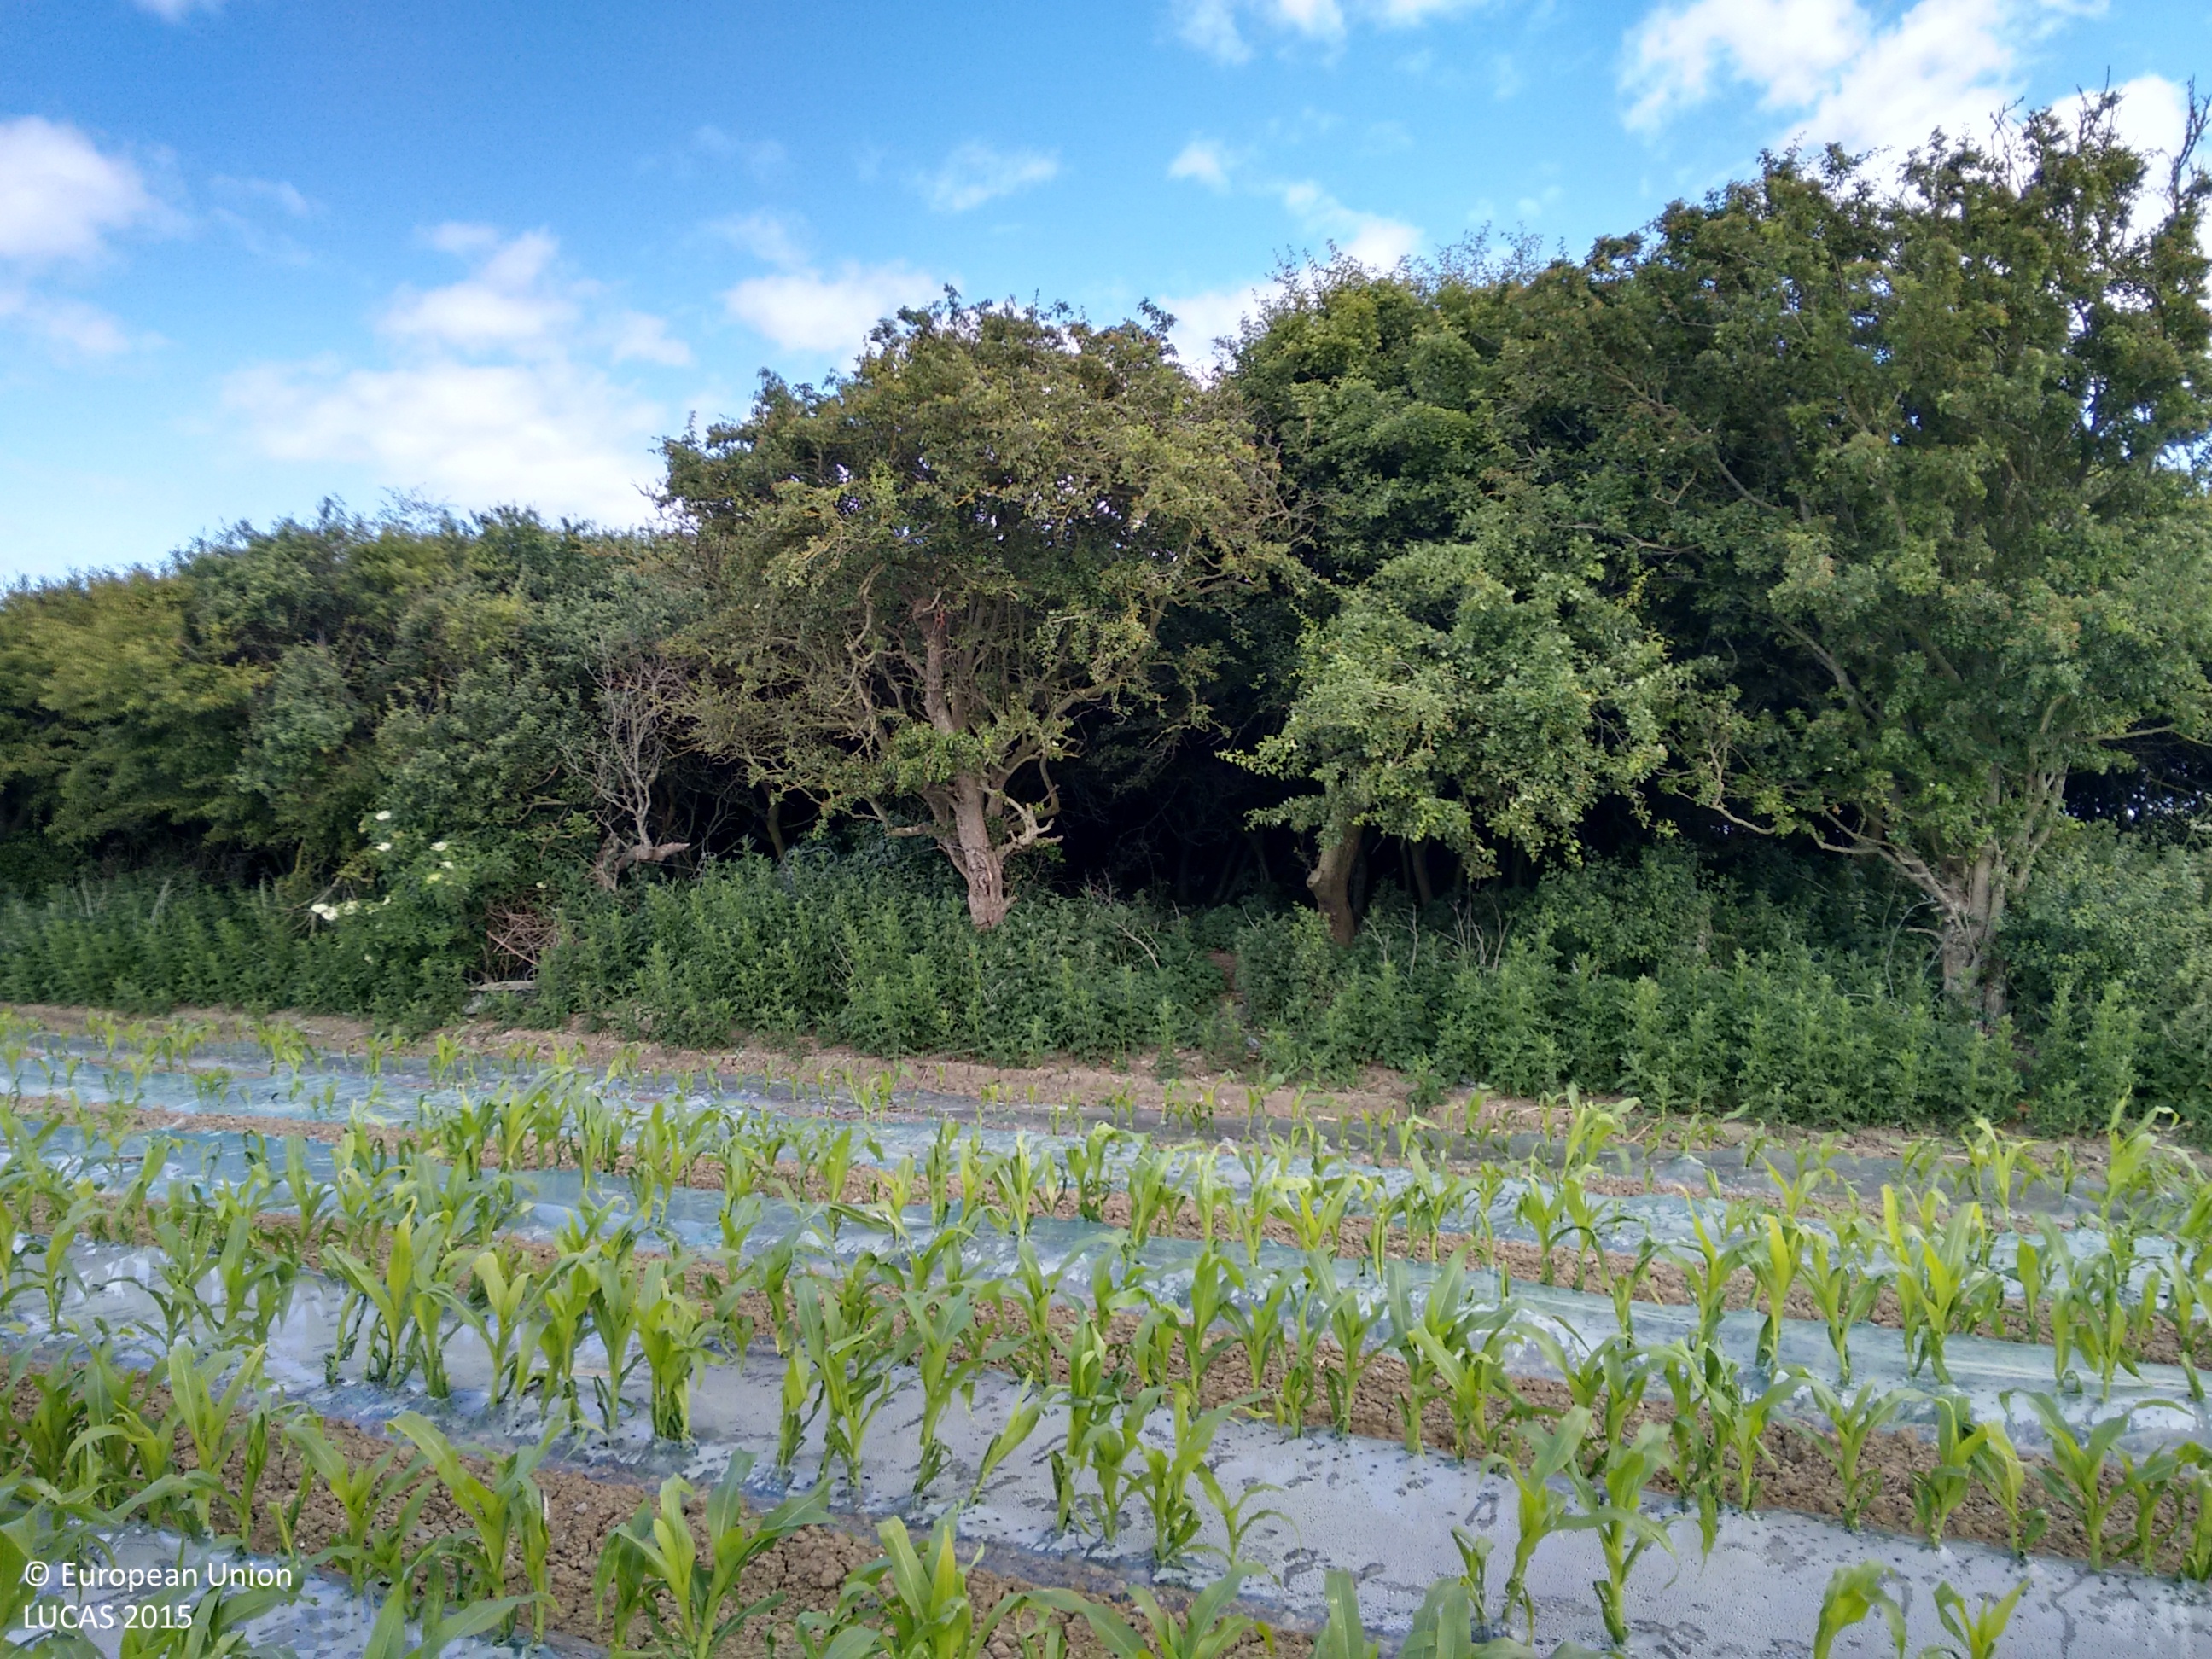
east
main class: Cropland
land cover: Maize
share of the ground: 50 - 75 %
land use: Agriculture (excluding fallow land and kitchen gardens)
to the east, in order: Maize; Abandoned hedges; Rock outcrops; Sand
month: June
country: IE
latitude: 53.6241
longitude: -6.1896
